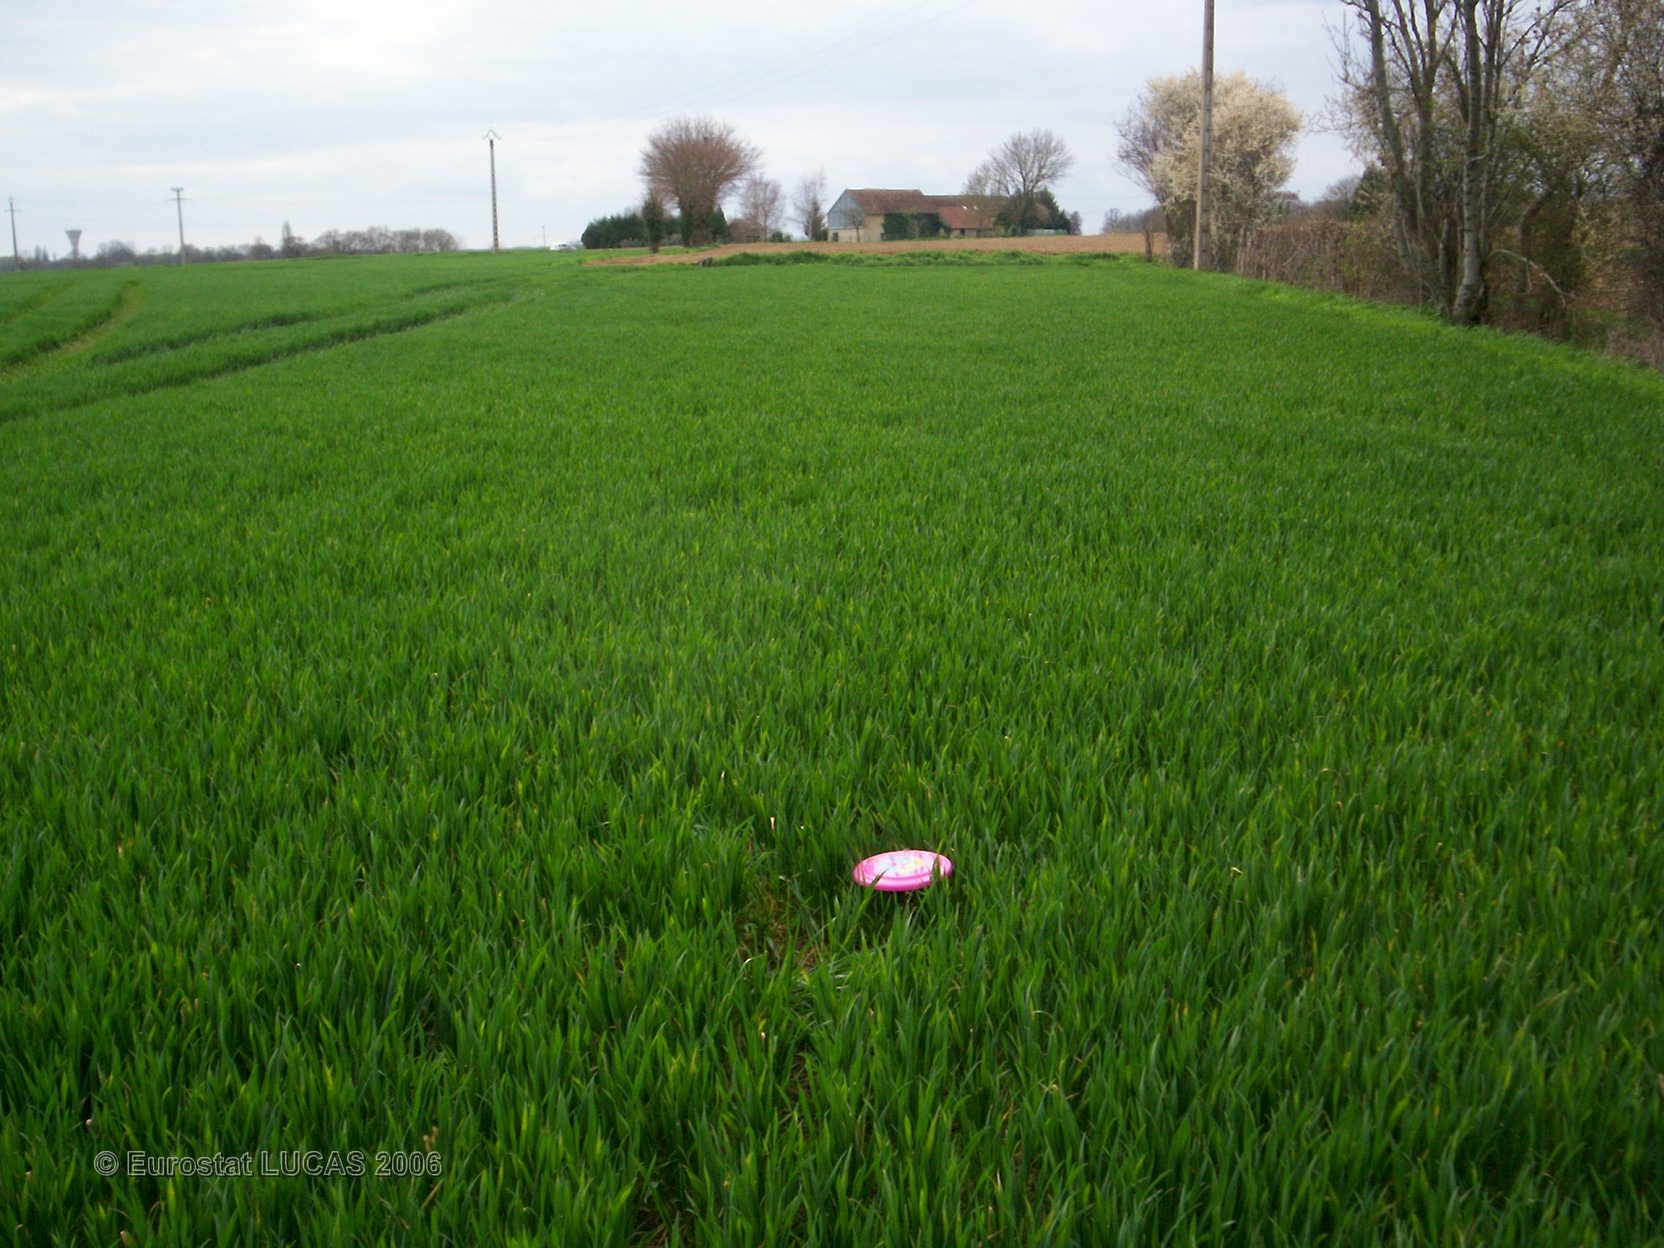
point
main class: Cropland
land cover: Common wheat
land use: Agriculture (excluding fallow land and kitchen gardens)
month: April
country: FR
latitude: 48.2696
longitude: 0.3413
